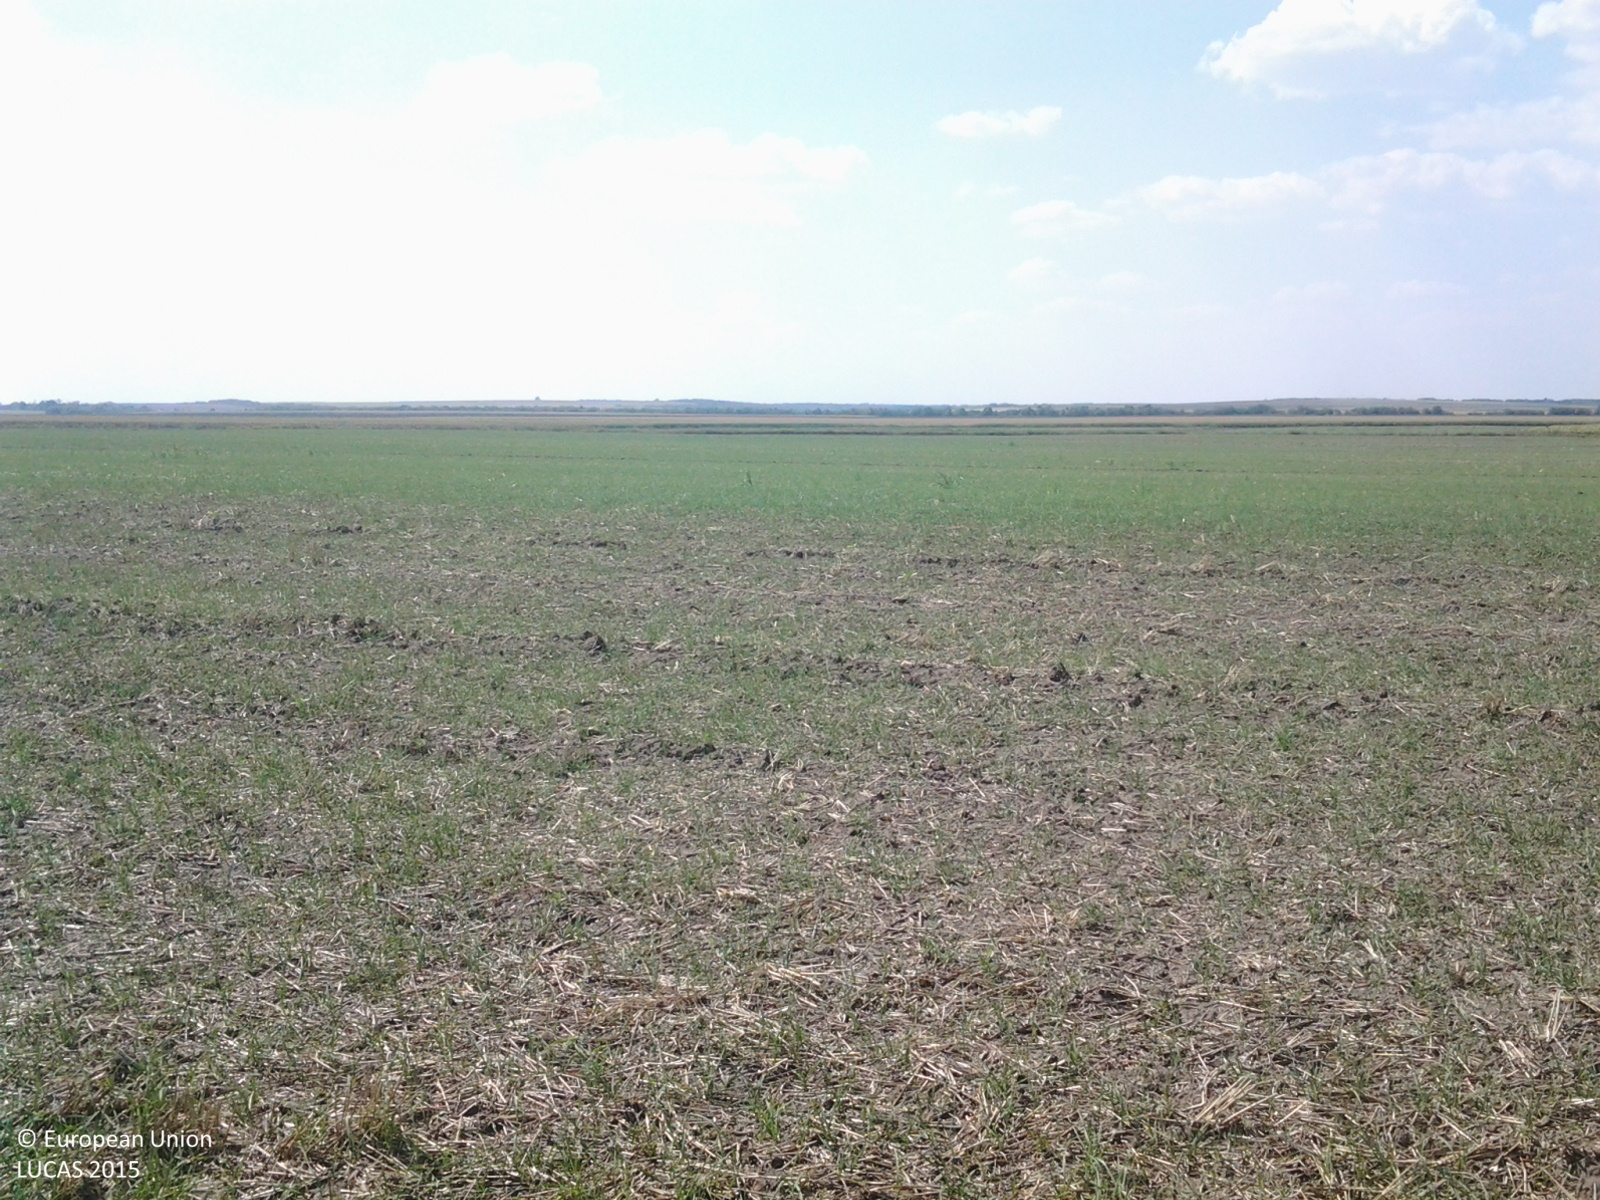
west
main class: Cropland
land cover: Common wheat
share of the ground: 10 - 25 %
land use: Agriculture (excluding fallow land and kitchen gardens)
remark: Harvested field
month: August
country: HU
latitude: 47.2861
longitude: 19.7140
